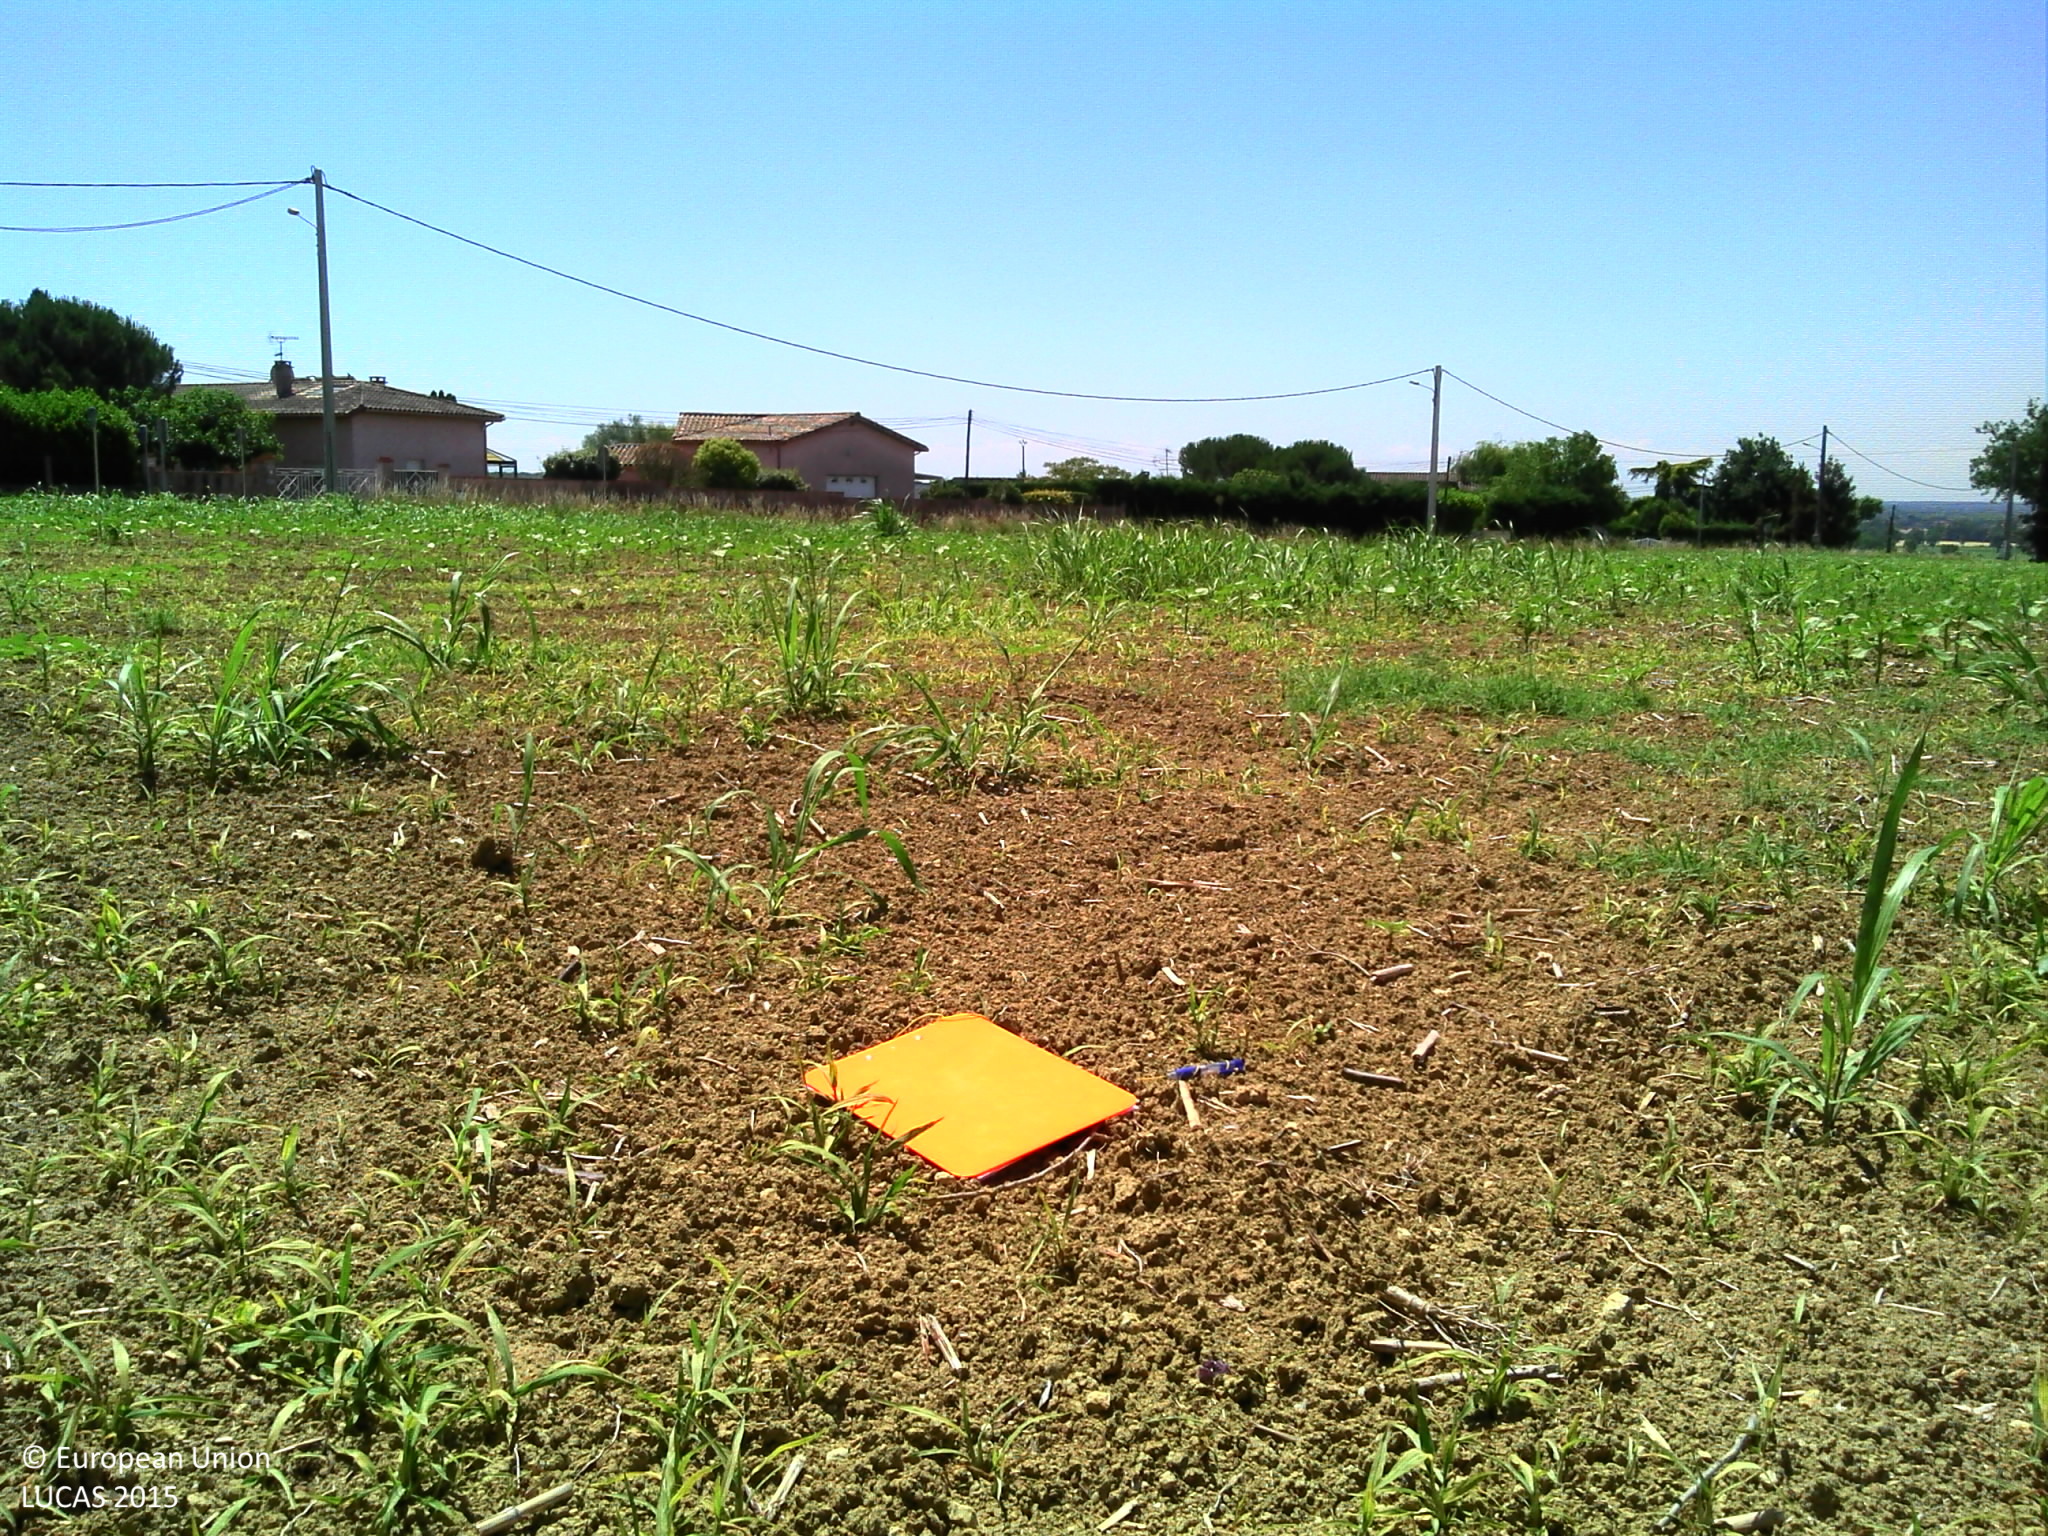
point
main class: Grassland
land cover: Spontaneously vegetated surfaces
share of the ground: 50 - 75 %
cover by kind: herbaceous plants 55 %, unconsolidated bare surface 45 %
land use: Agriculture (excluding fallow land and kitchen gardens)
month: June
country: FR
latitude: 43.7747
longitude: 1.3916
